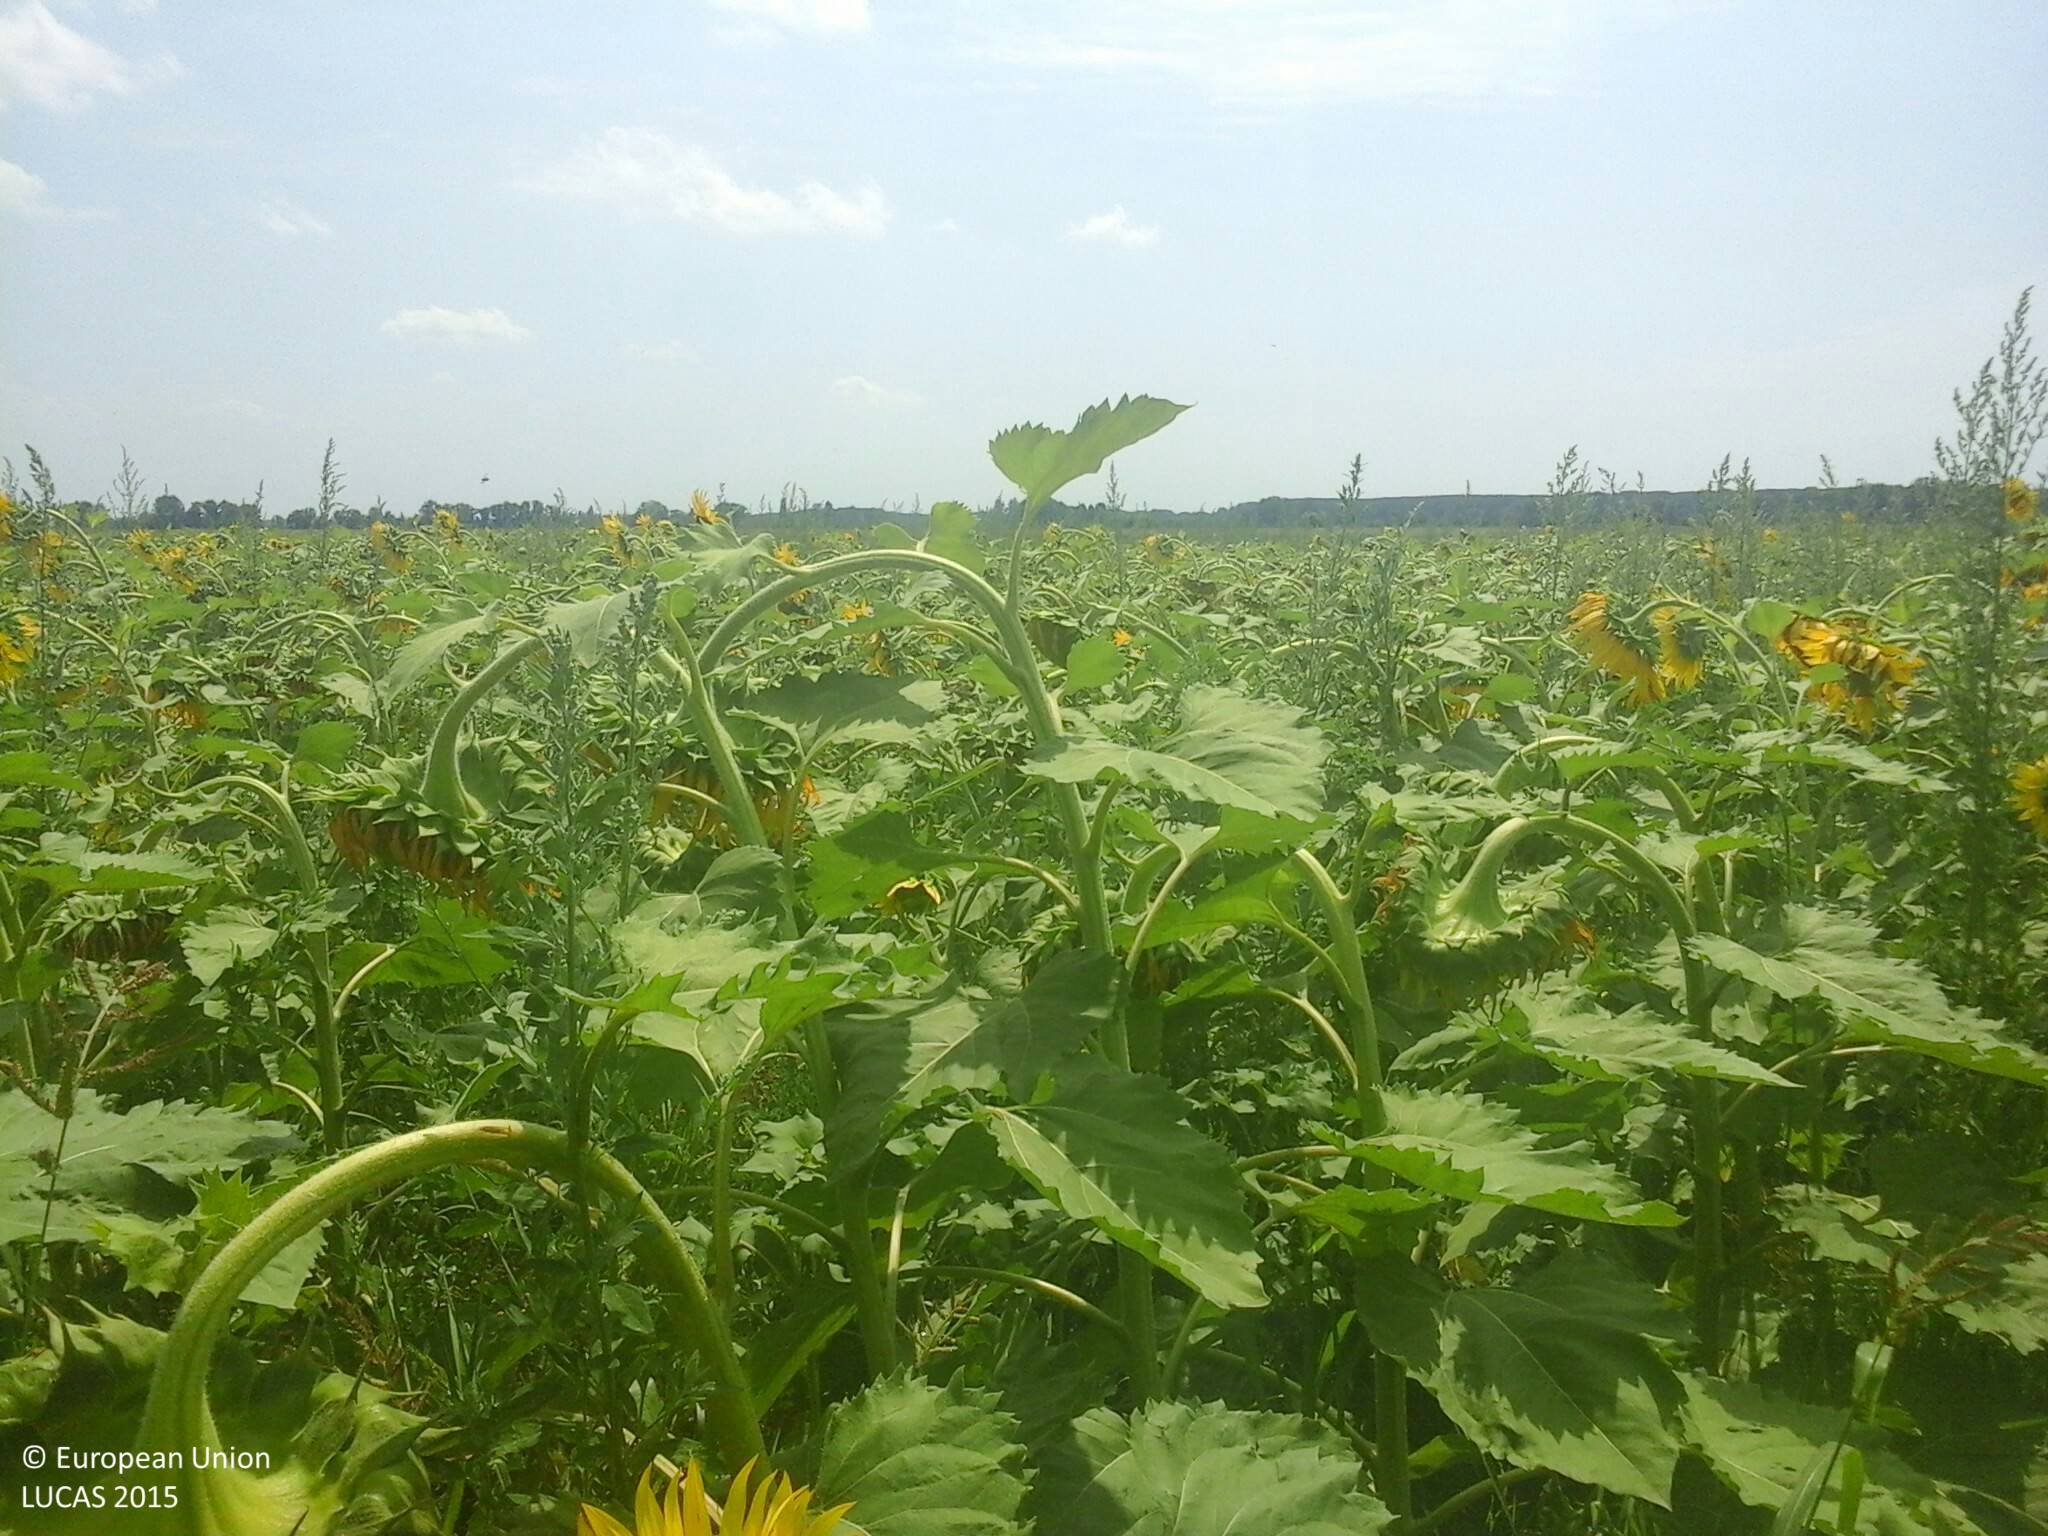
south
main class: Cropland
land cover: Sunflower
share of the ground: > 75 %
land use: Agriculture (excluding fallow land and kitchen gardens)
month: July
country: HU
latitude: 46.7974
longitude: 20.0992
